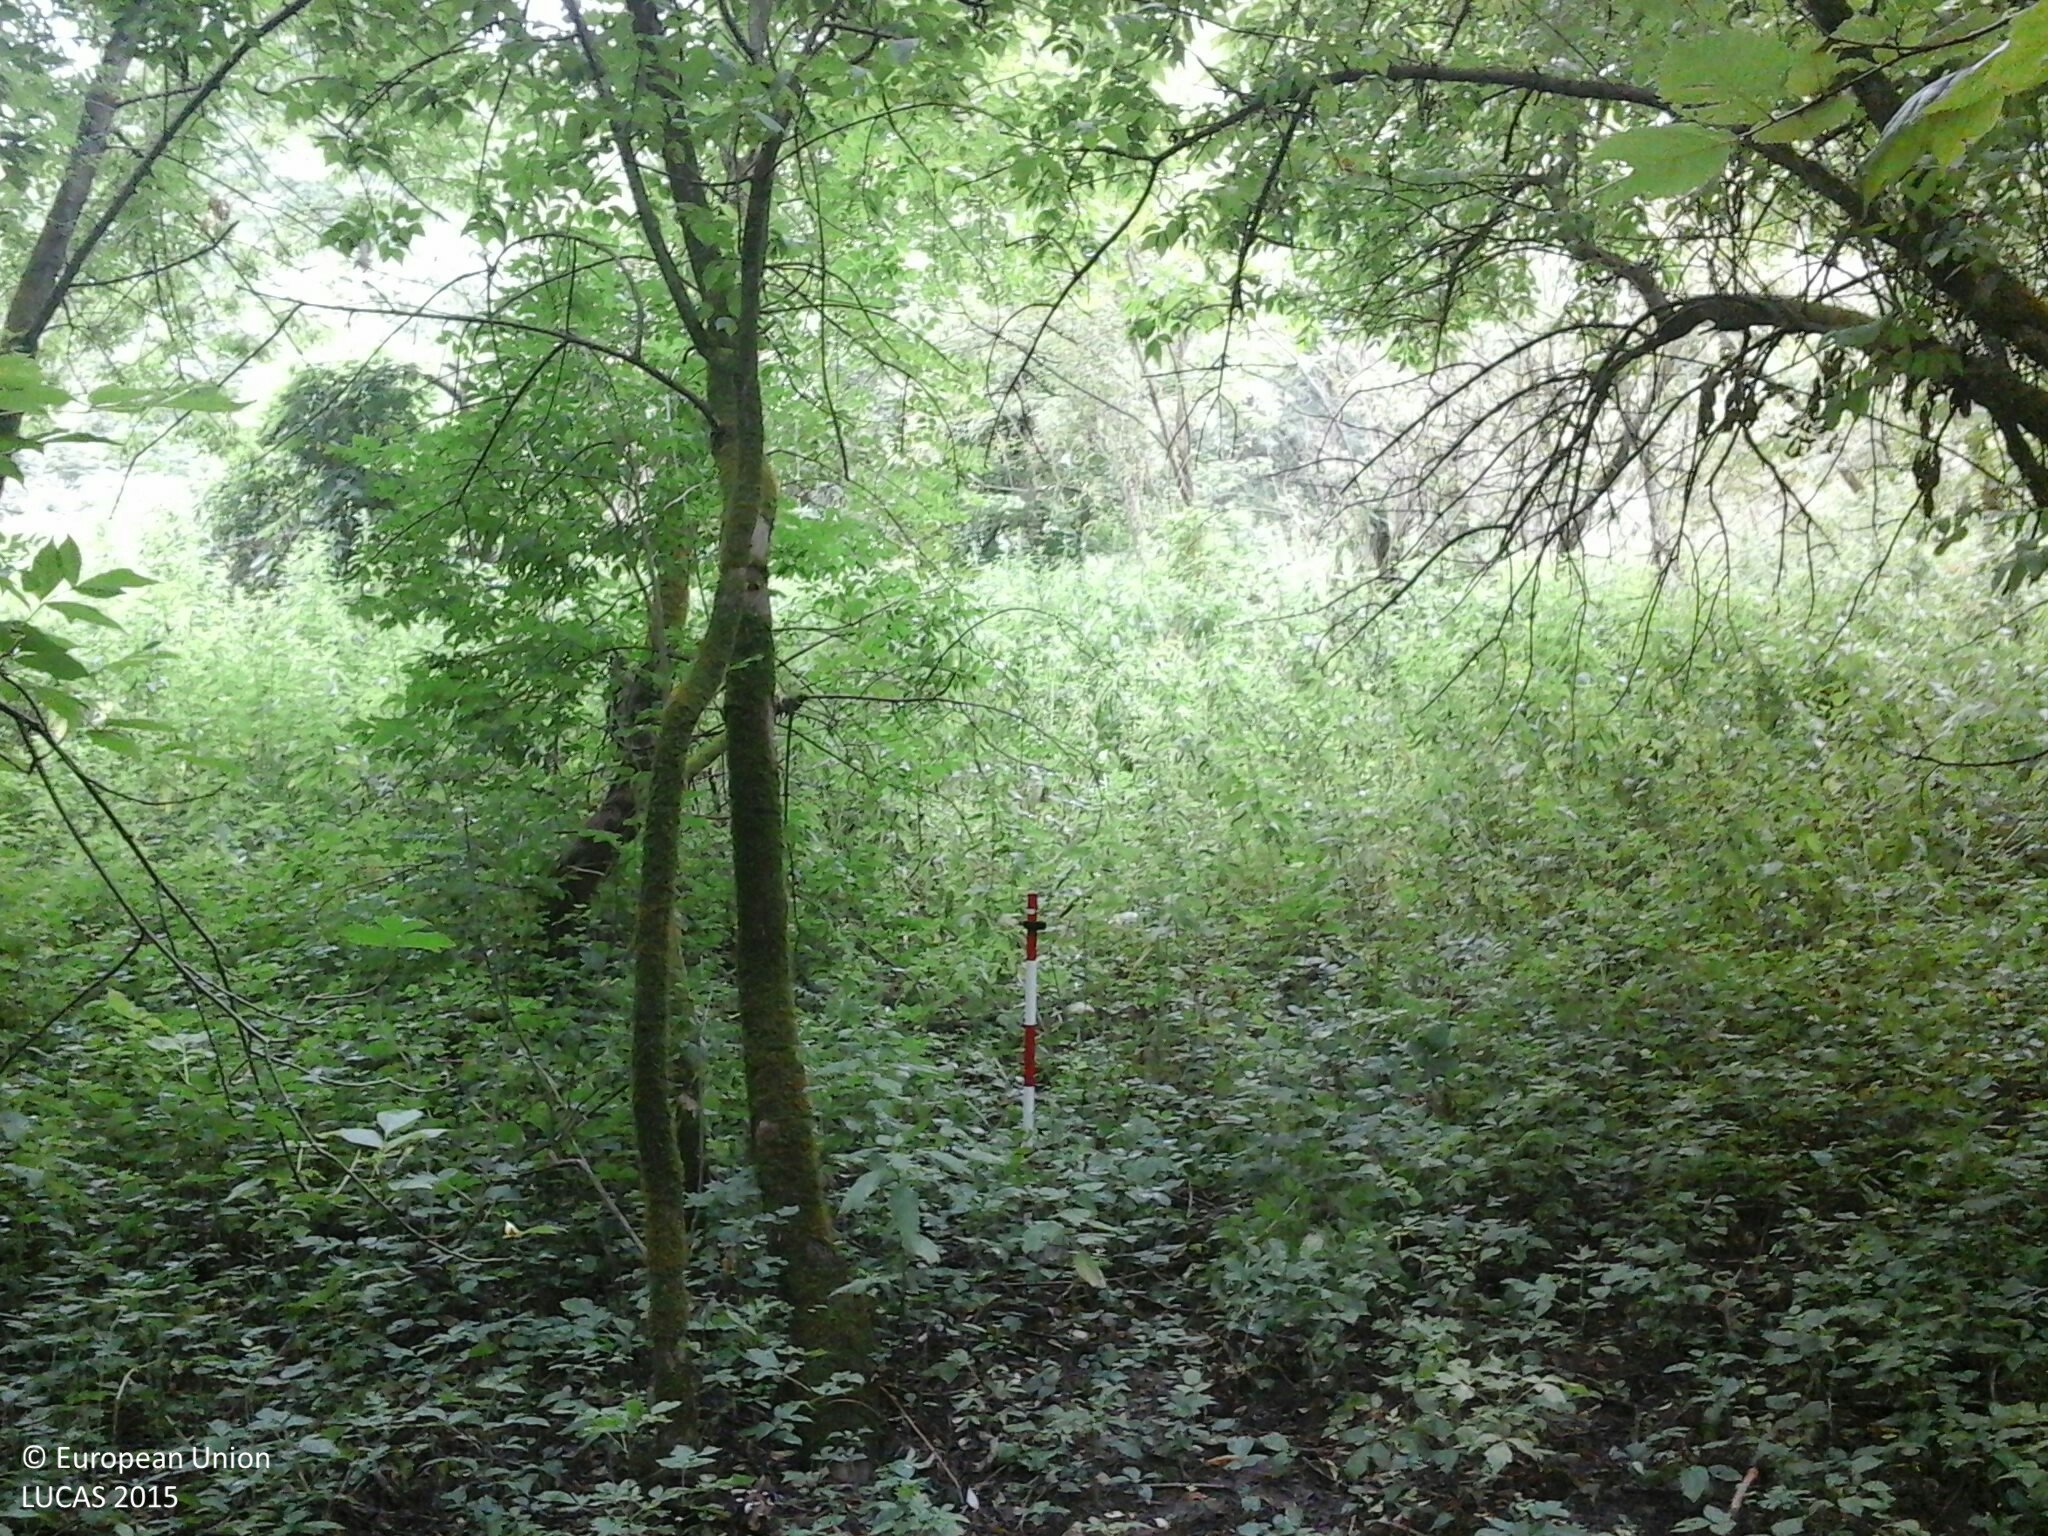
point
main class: Woodland
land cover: Broadleaved woodland
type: mesophytic deciduous forest
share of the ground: > 75 %
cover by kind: broadleaved forest trees 95 %, herbaceous plants 5 %
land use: Forestry
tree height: > 5 m
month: July
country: HU
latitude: 48.3008
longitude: 22.2574
